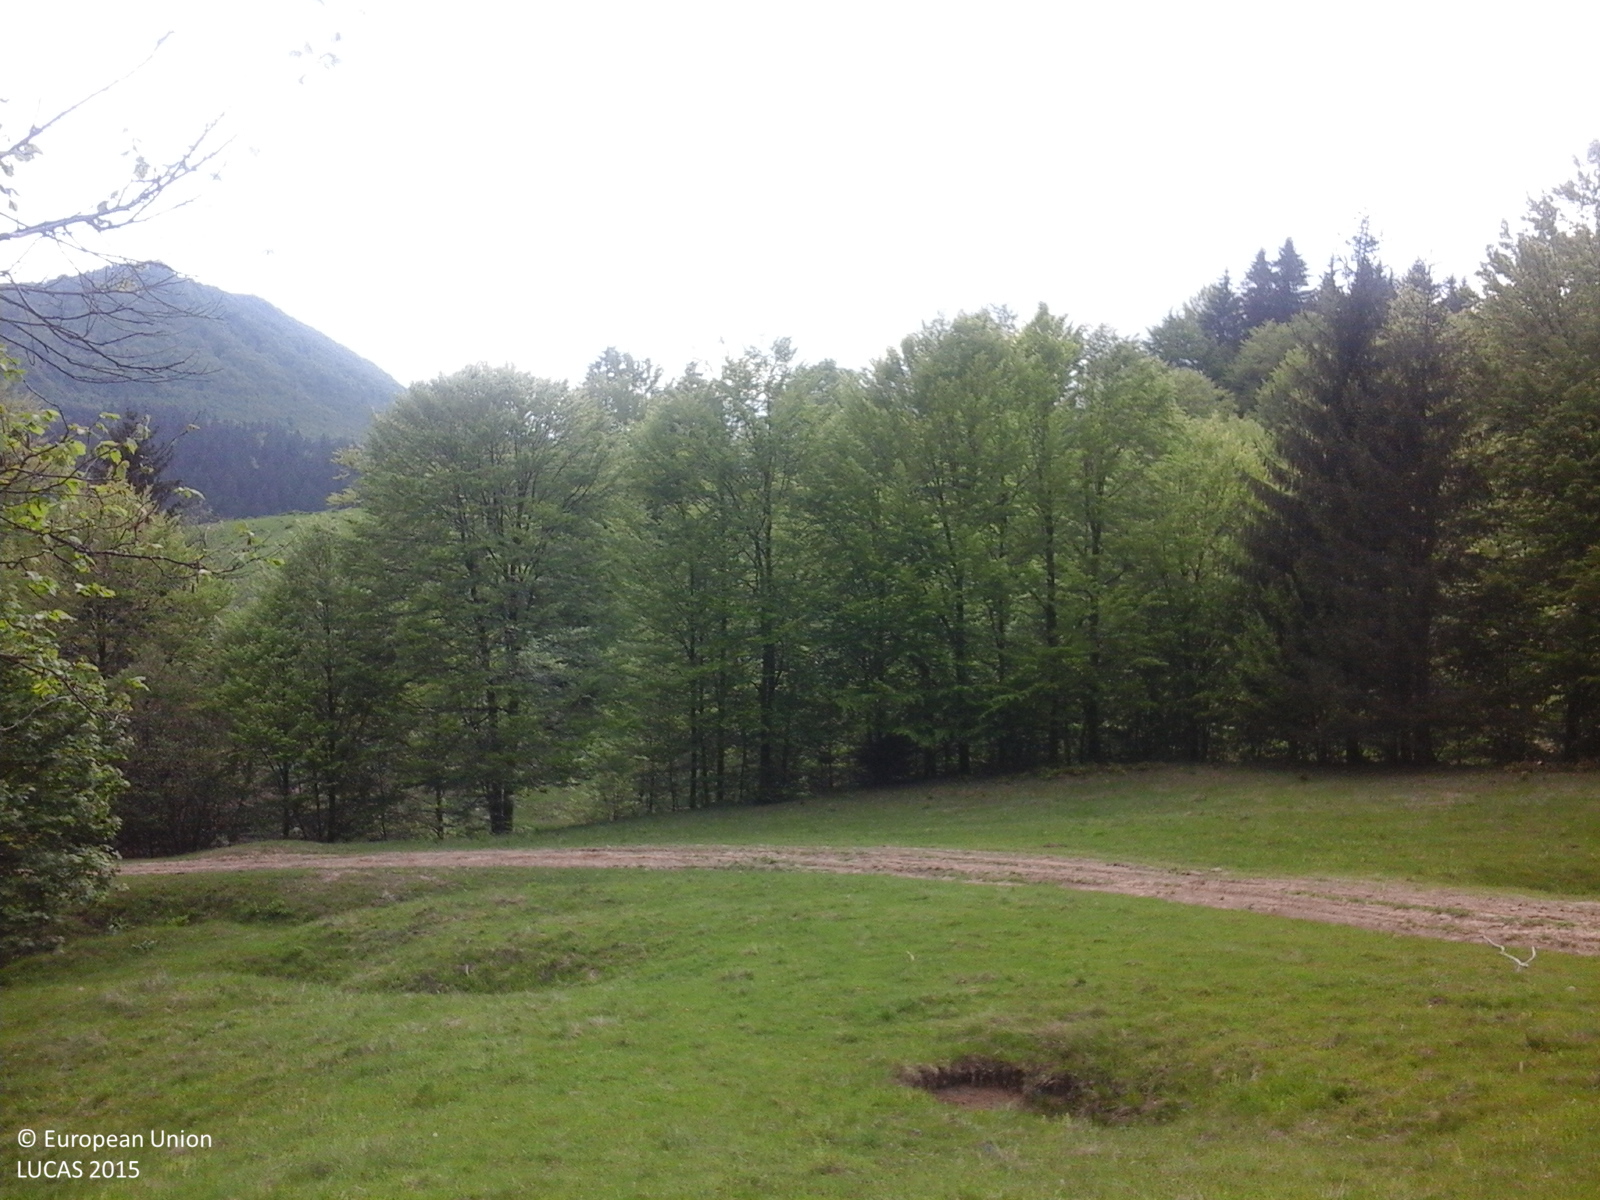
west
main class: Grassland
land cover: Grassland without tree/shrub cover
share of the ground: > 75 %
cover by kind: herbaceous plants 100 %
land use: Agriculture (excluding fallow land and kitchen gardens)
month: May
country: RO
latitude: 45.6037
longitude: 25.9466
